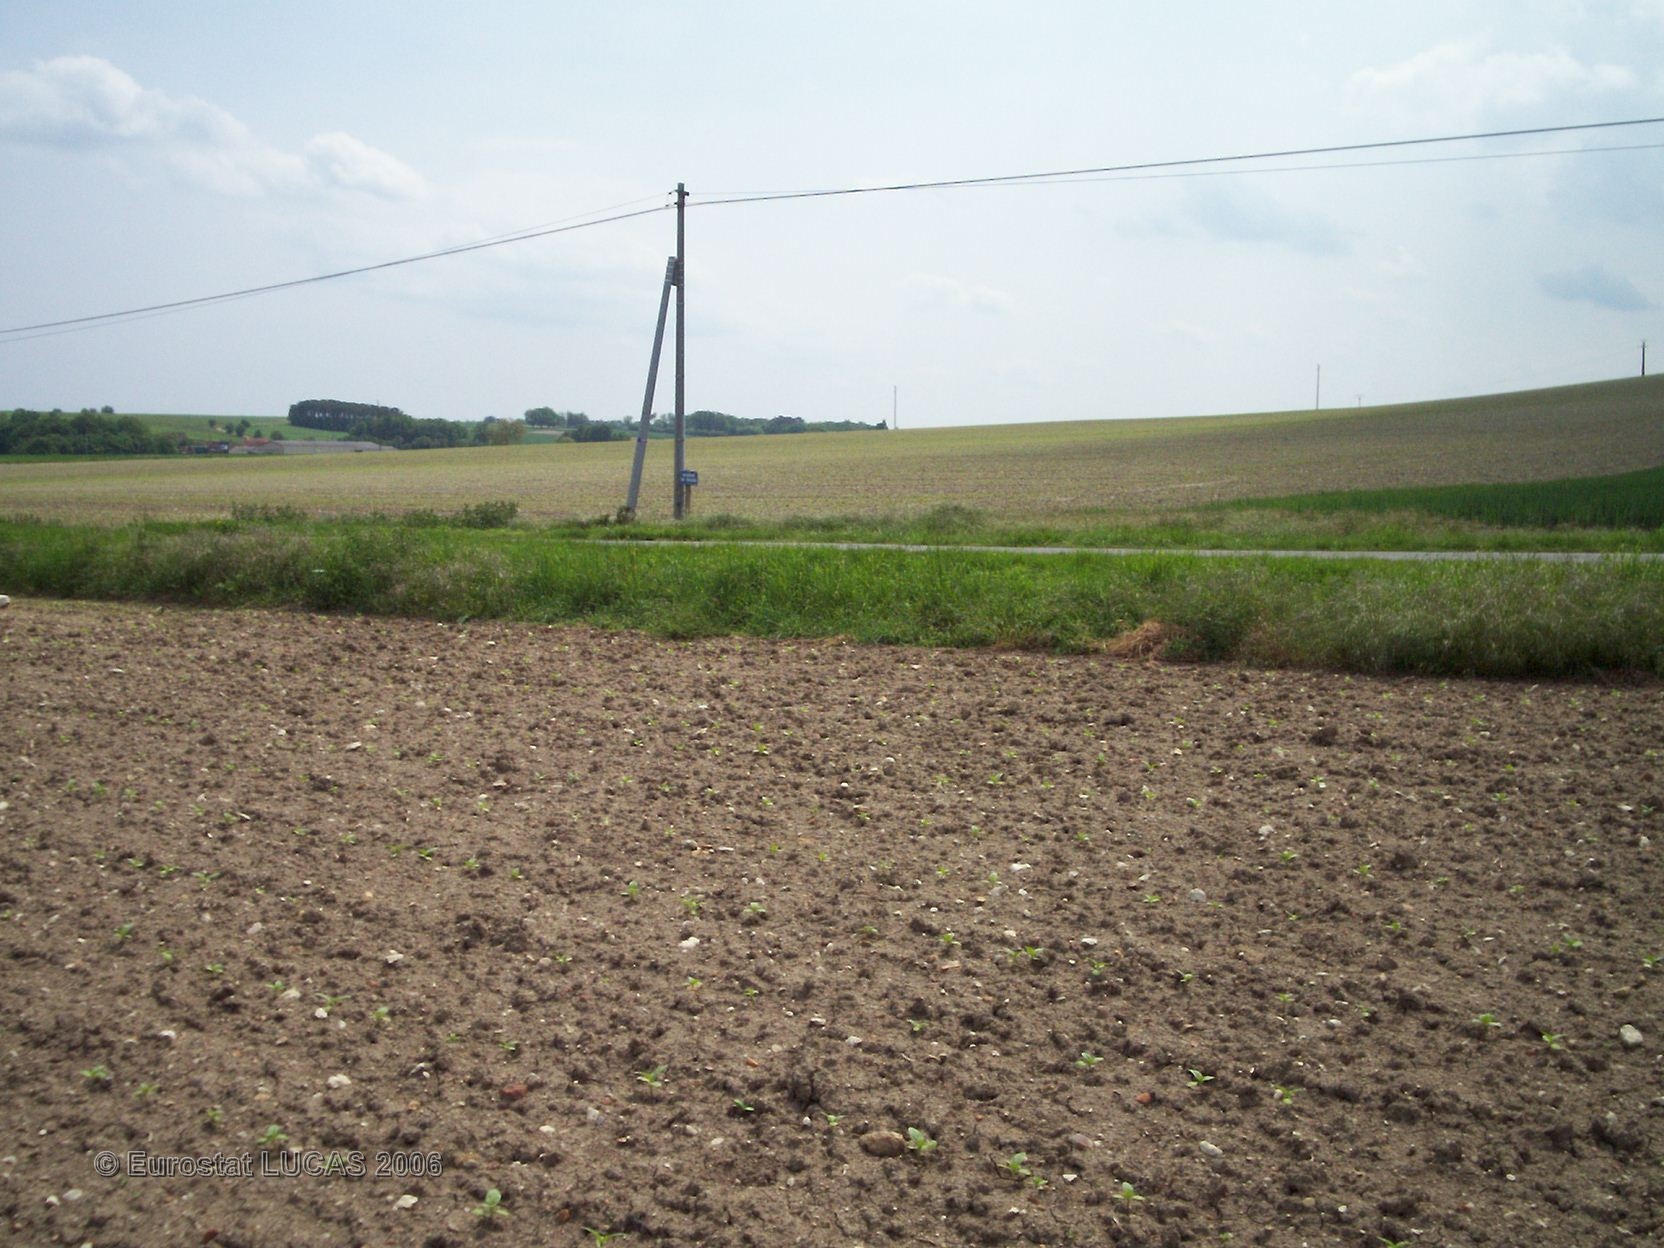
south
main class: Cropland
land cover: Sunflower
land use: Agriculture (excluding fallow land and kitchen gardens)
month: May
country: FR
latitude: 46.8209
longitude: 0.9801
